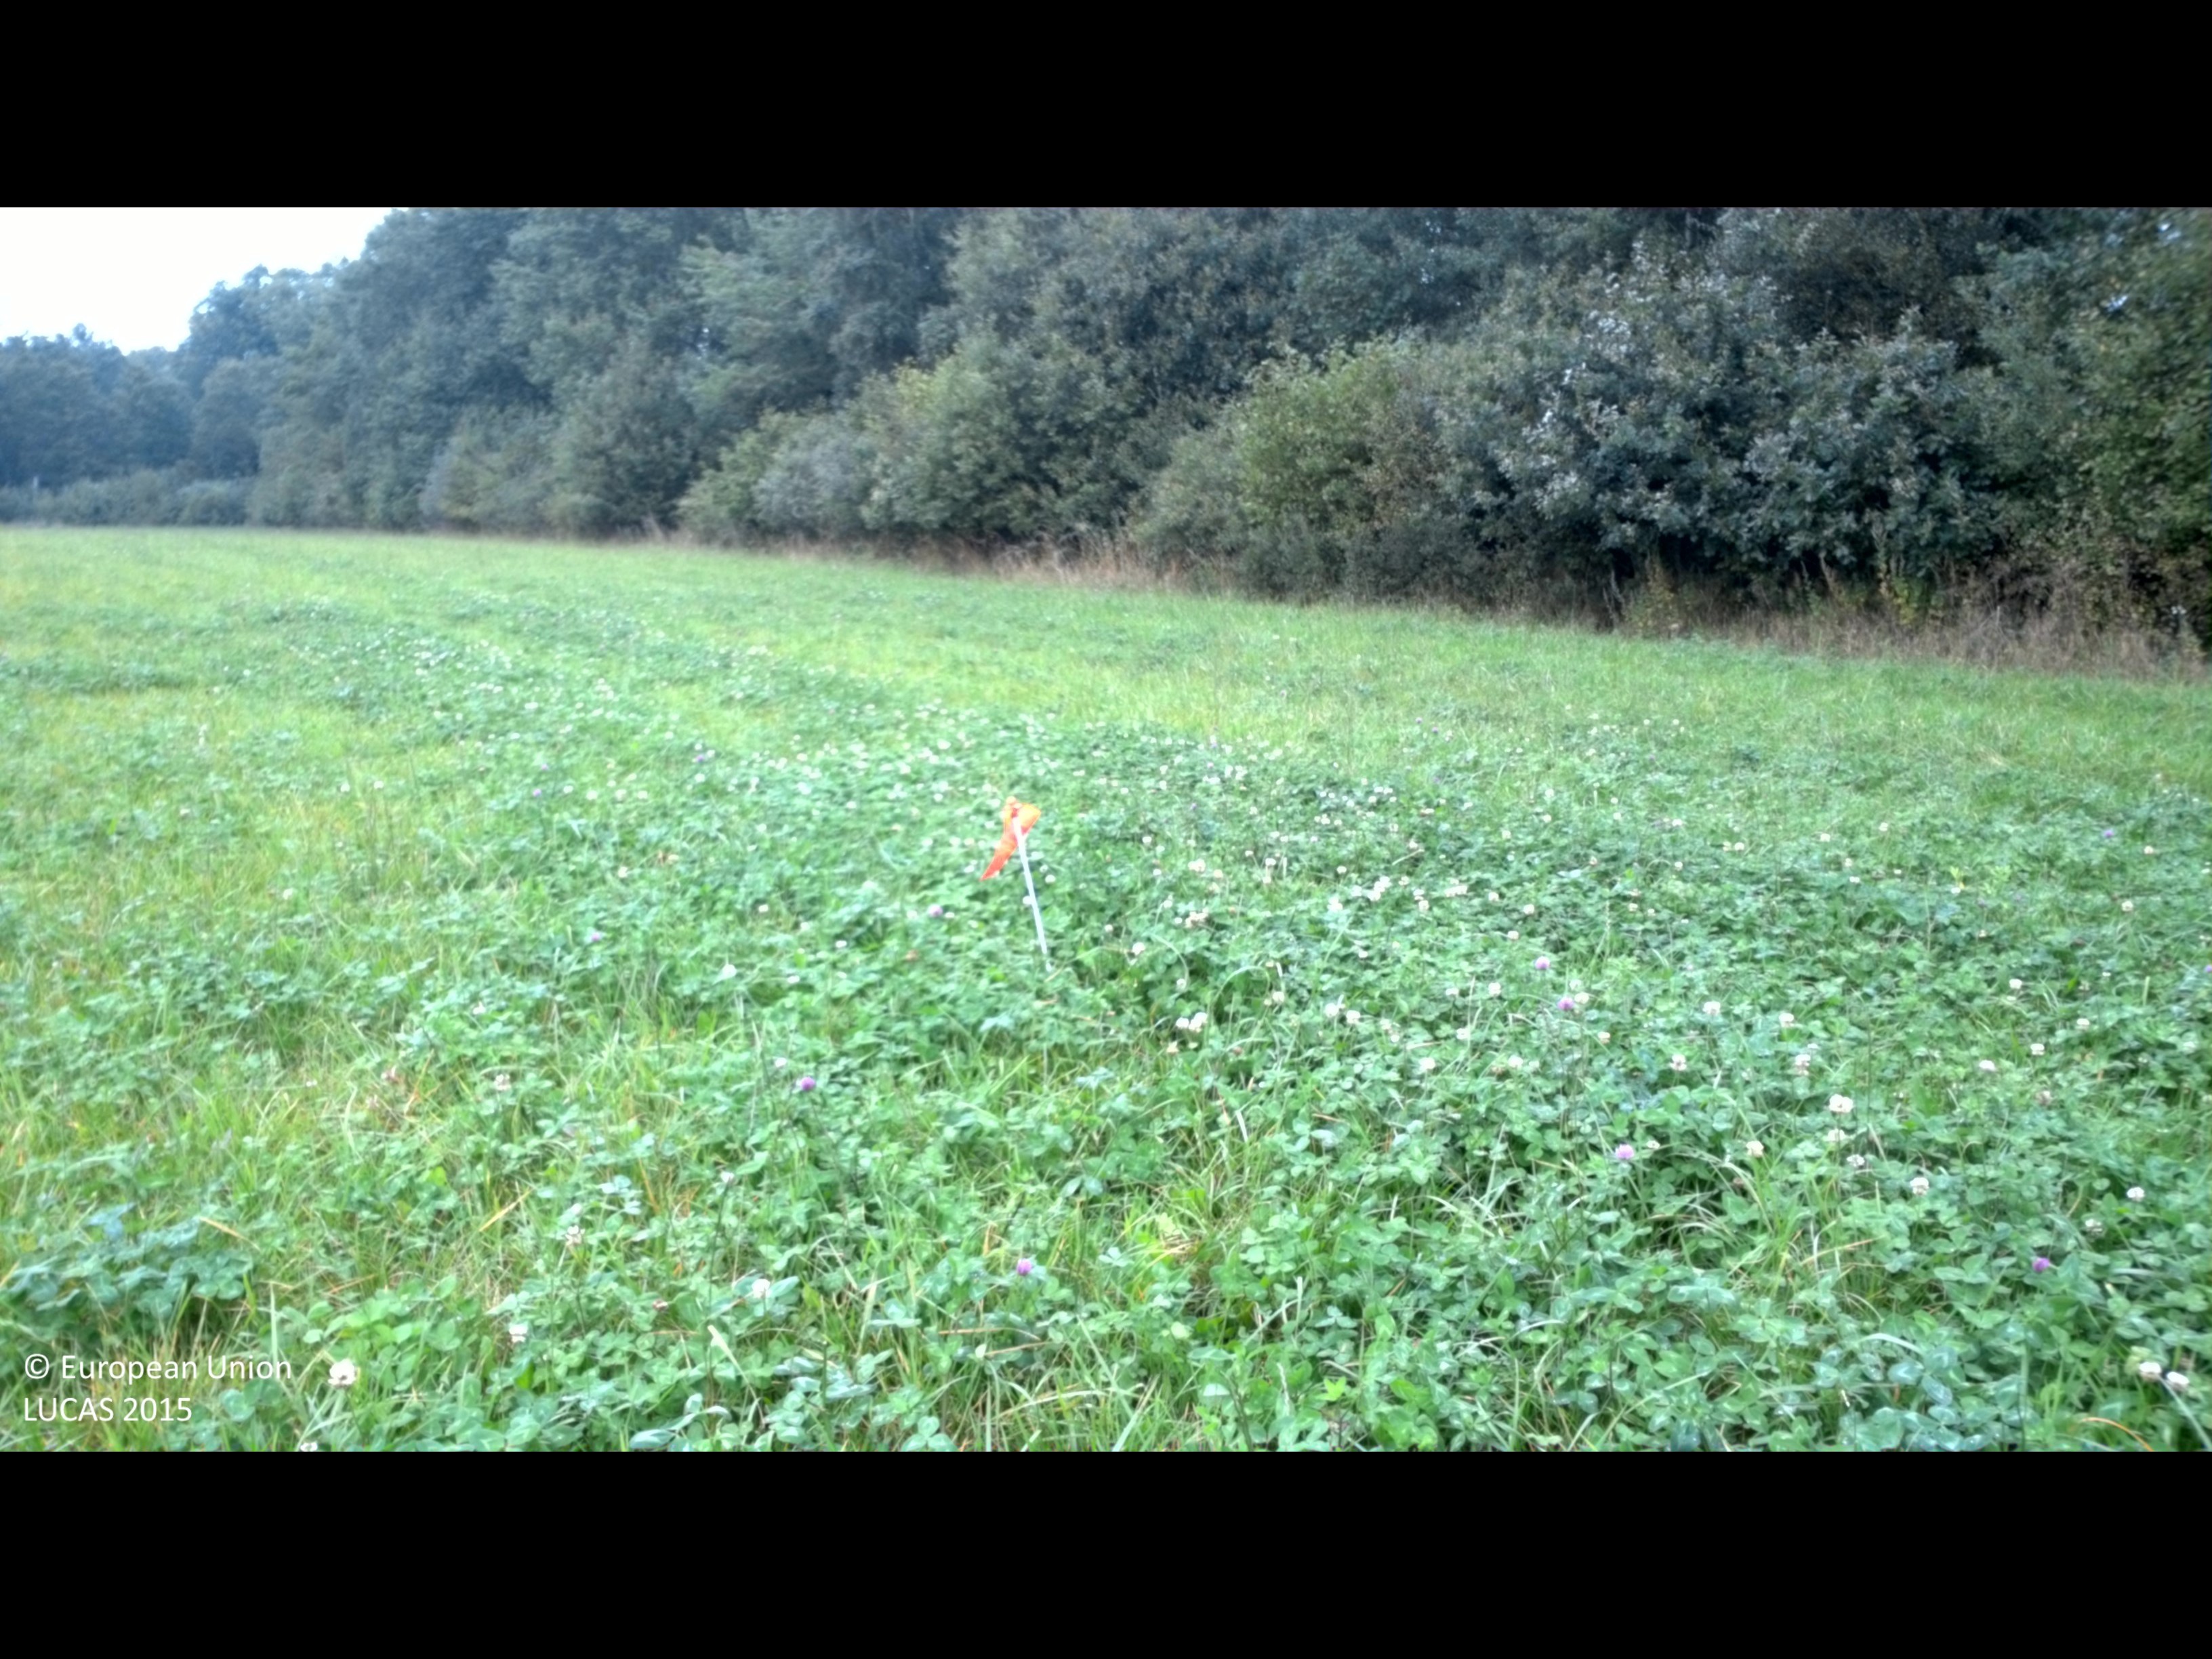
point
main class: Cropland
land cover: Clovers
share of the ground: > 75 %
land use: Agriculture (excluding fallow land and kitchen gardens)
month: September
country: SE
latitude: 55.9629
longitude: 14.0188
